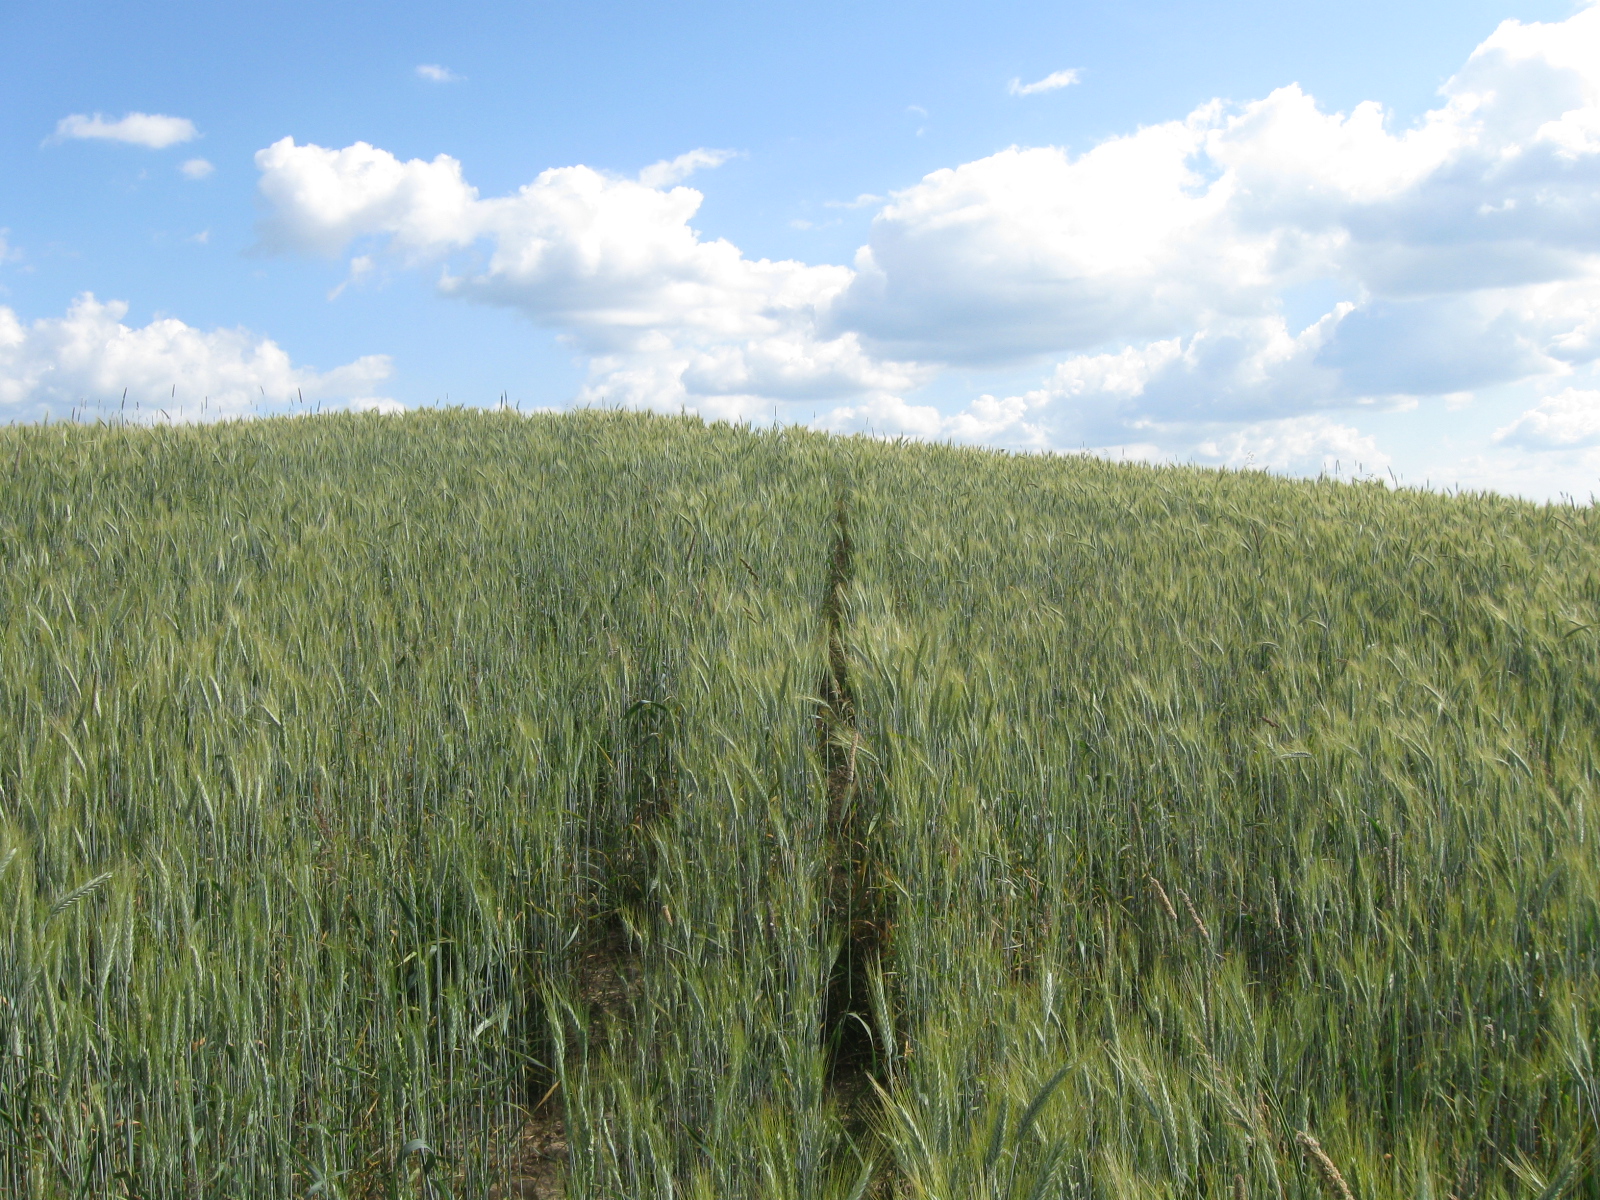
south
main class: Cropland
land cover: Triticale
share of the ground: > 75 %
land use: Agriculture (excluding fallow land and kitchen gardens)
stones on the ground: < 10 %
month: July
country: LT
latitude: 54.2477
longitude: 24.2949
